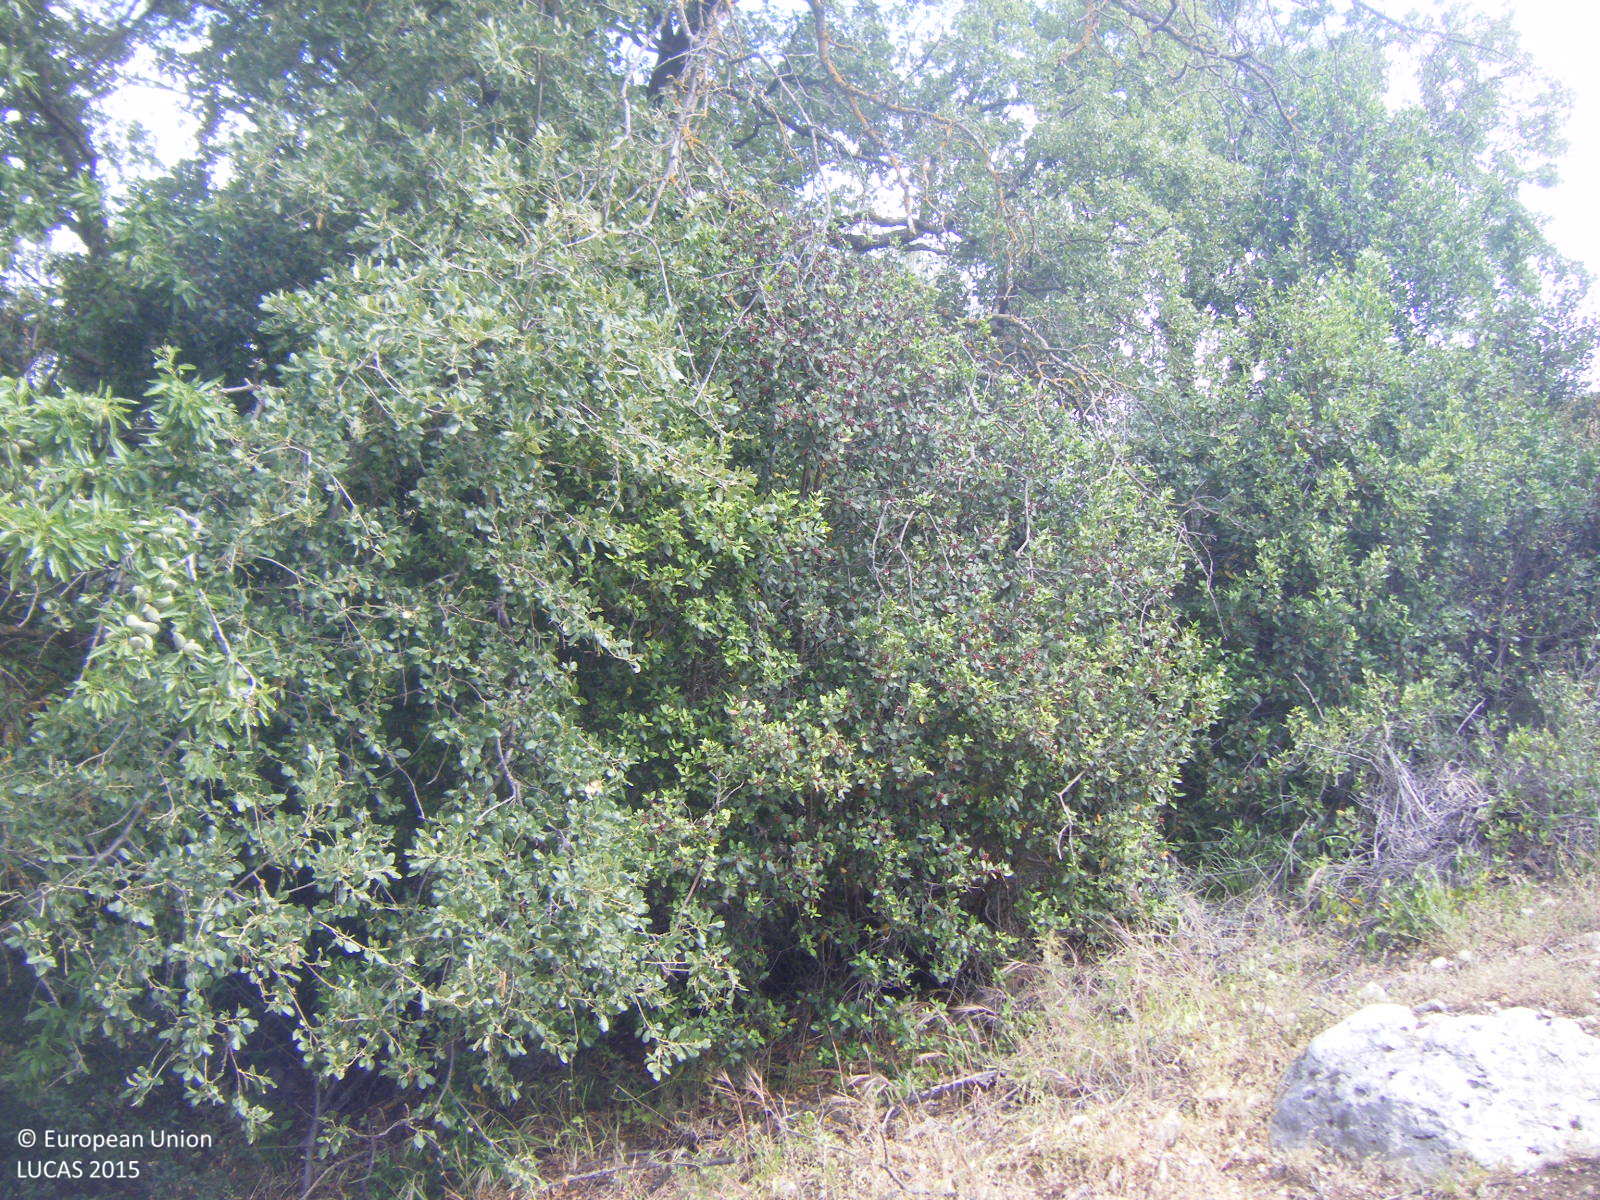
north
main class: Cropland
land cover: Olive groves
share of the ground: 10 - 25 %
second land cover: Spontaneously vegetated surfaces
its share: > 75 %
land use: Agriculture (excluding fallow land and kitchen gardens)
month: May
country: ES
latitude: 36.9855
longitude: -4.3406
